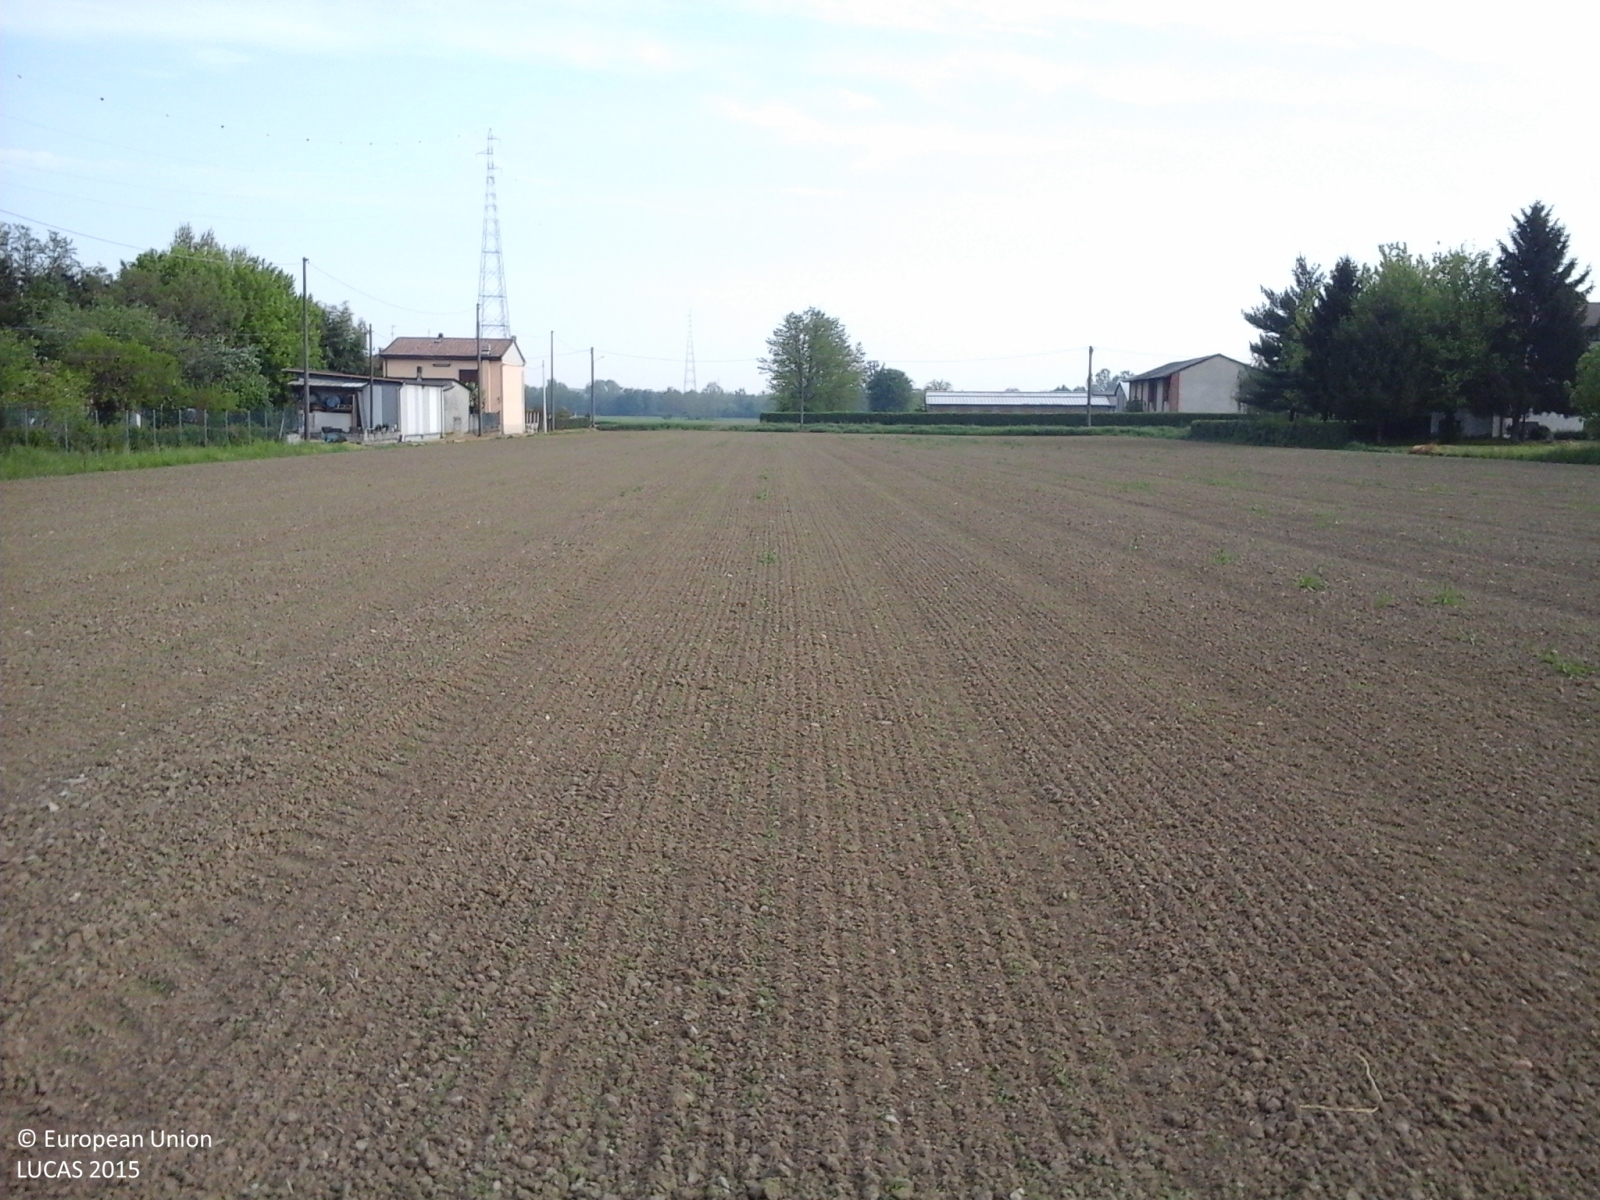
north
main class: Cropland
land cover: Lucerne
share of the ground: < 10 %
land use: Agriculture (excluding fallow land and kitchen gardens)
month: April
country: IT
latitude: 45.0880
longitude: 9.3786
